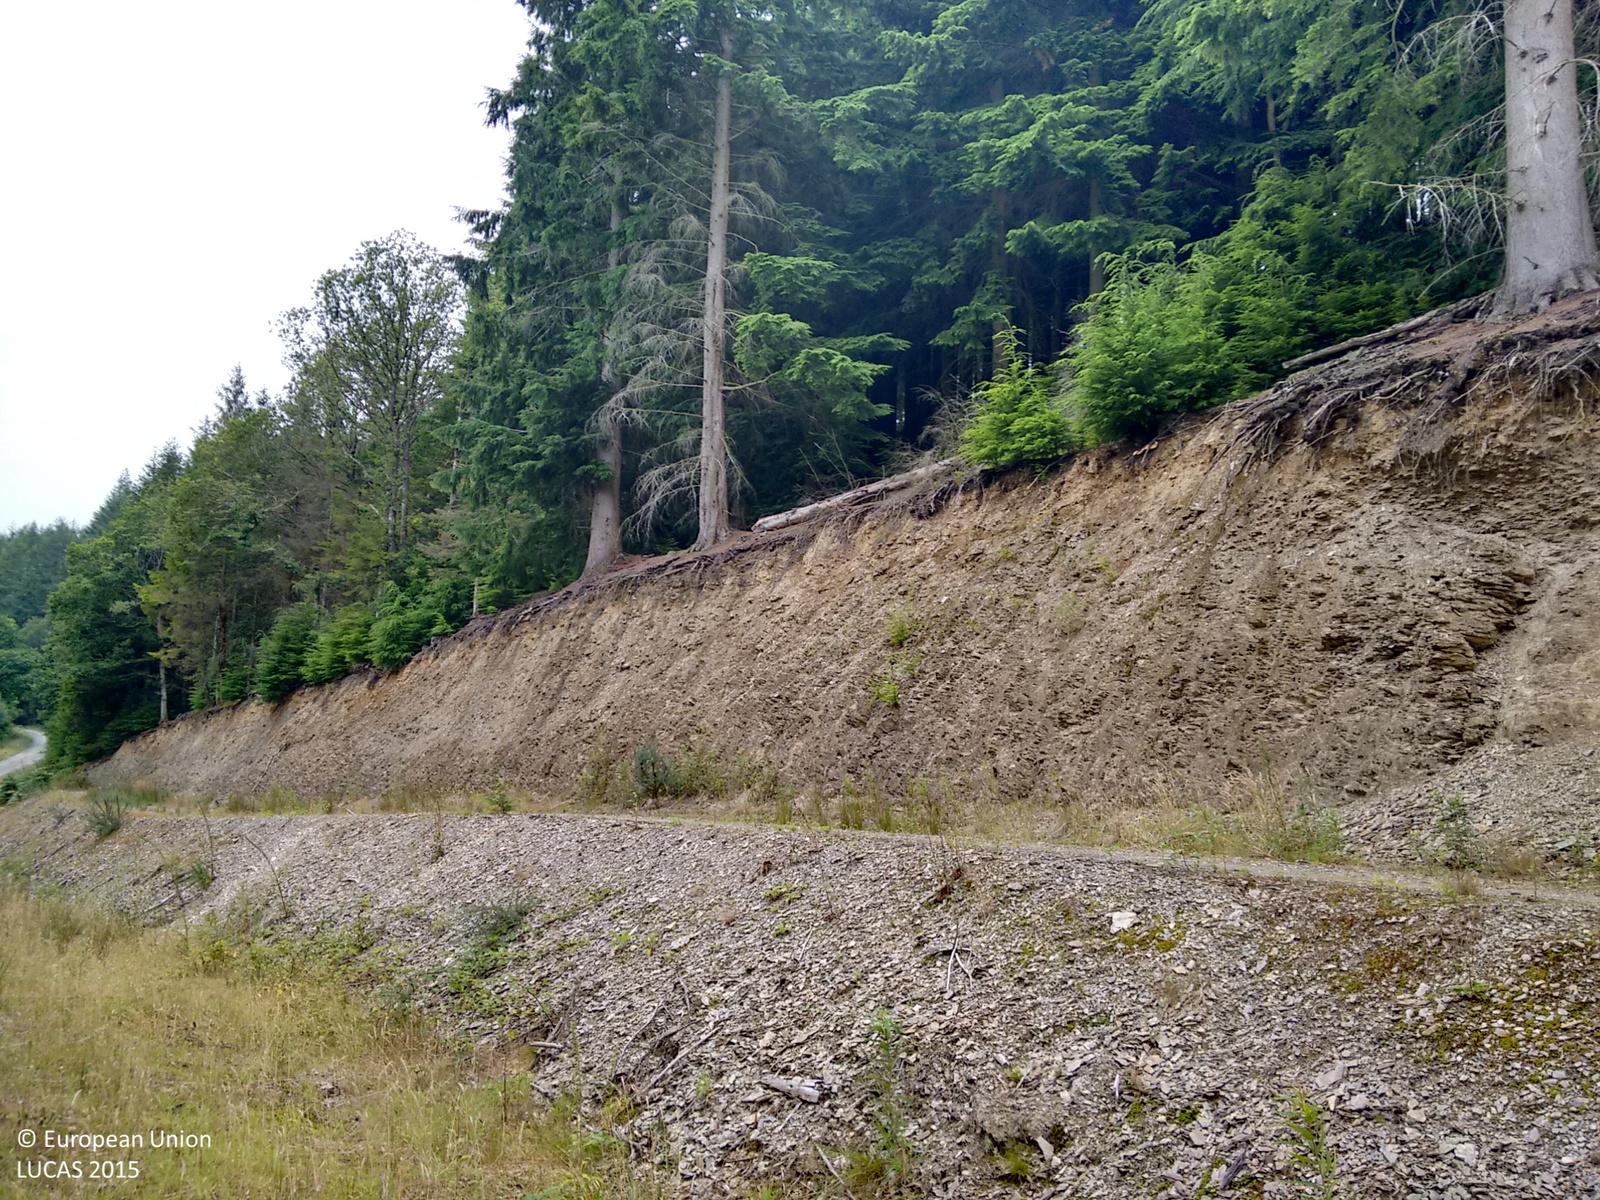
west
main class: Woodland
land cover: Spruce dominated coniferous woodland
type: exotic forest
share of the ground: > 75 %
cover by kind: coniferous forest trees 90 %, shrubs 10 %
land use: Forestry
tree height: > 5 m
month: August
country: GB
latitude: 52.0789
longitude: -3.9407
